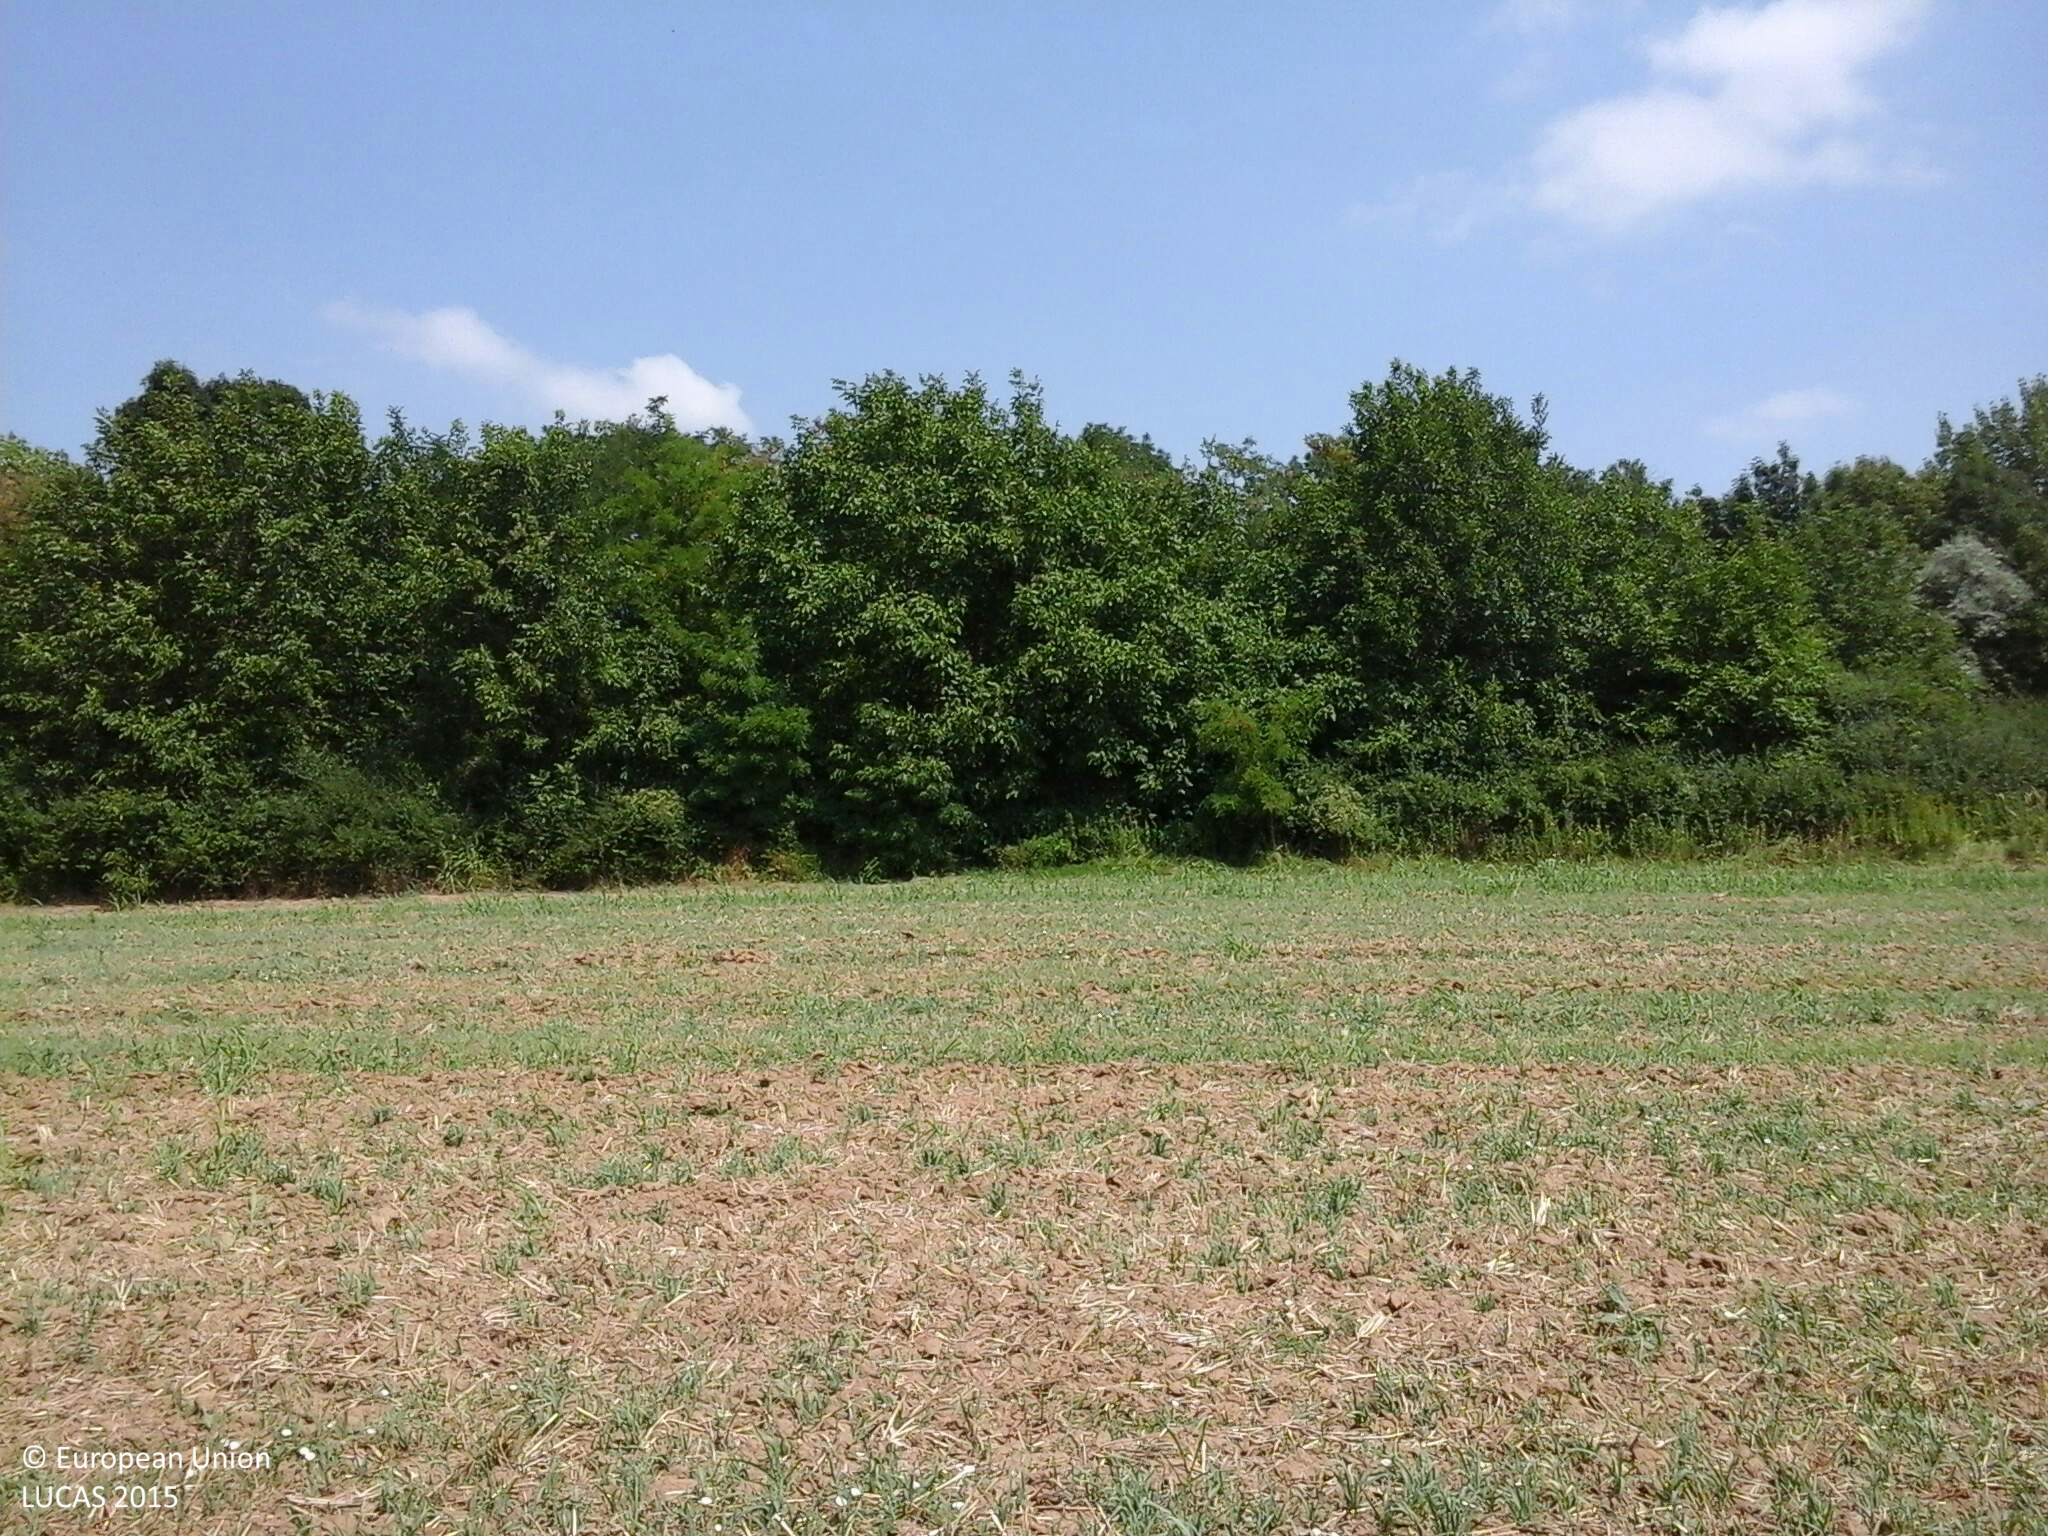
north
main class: Cropland
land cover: Common wheat
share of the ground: < 10 %
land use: Agriculture (excluding fallow land and kitchen gardens)
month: August
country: HU
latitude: 45.8741
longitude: 18.1870
